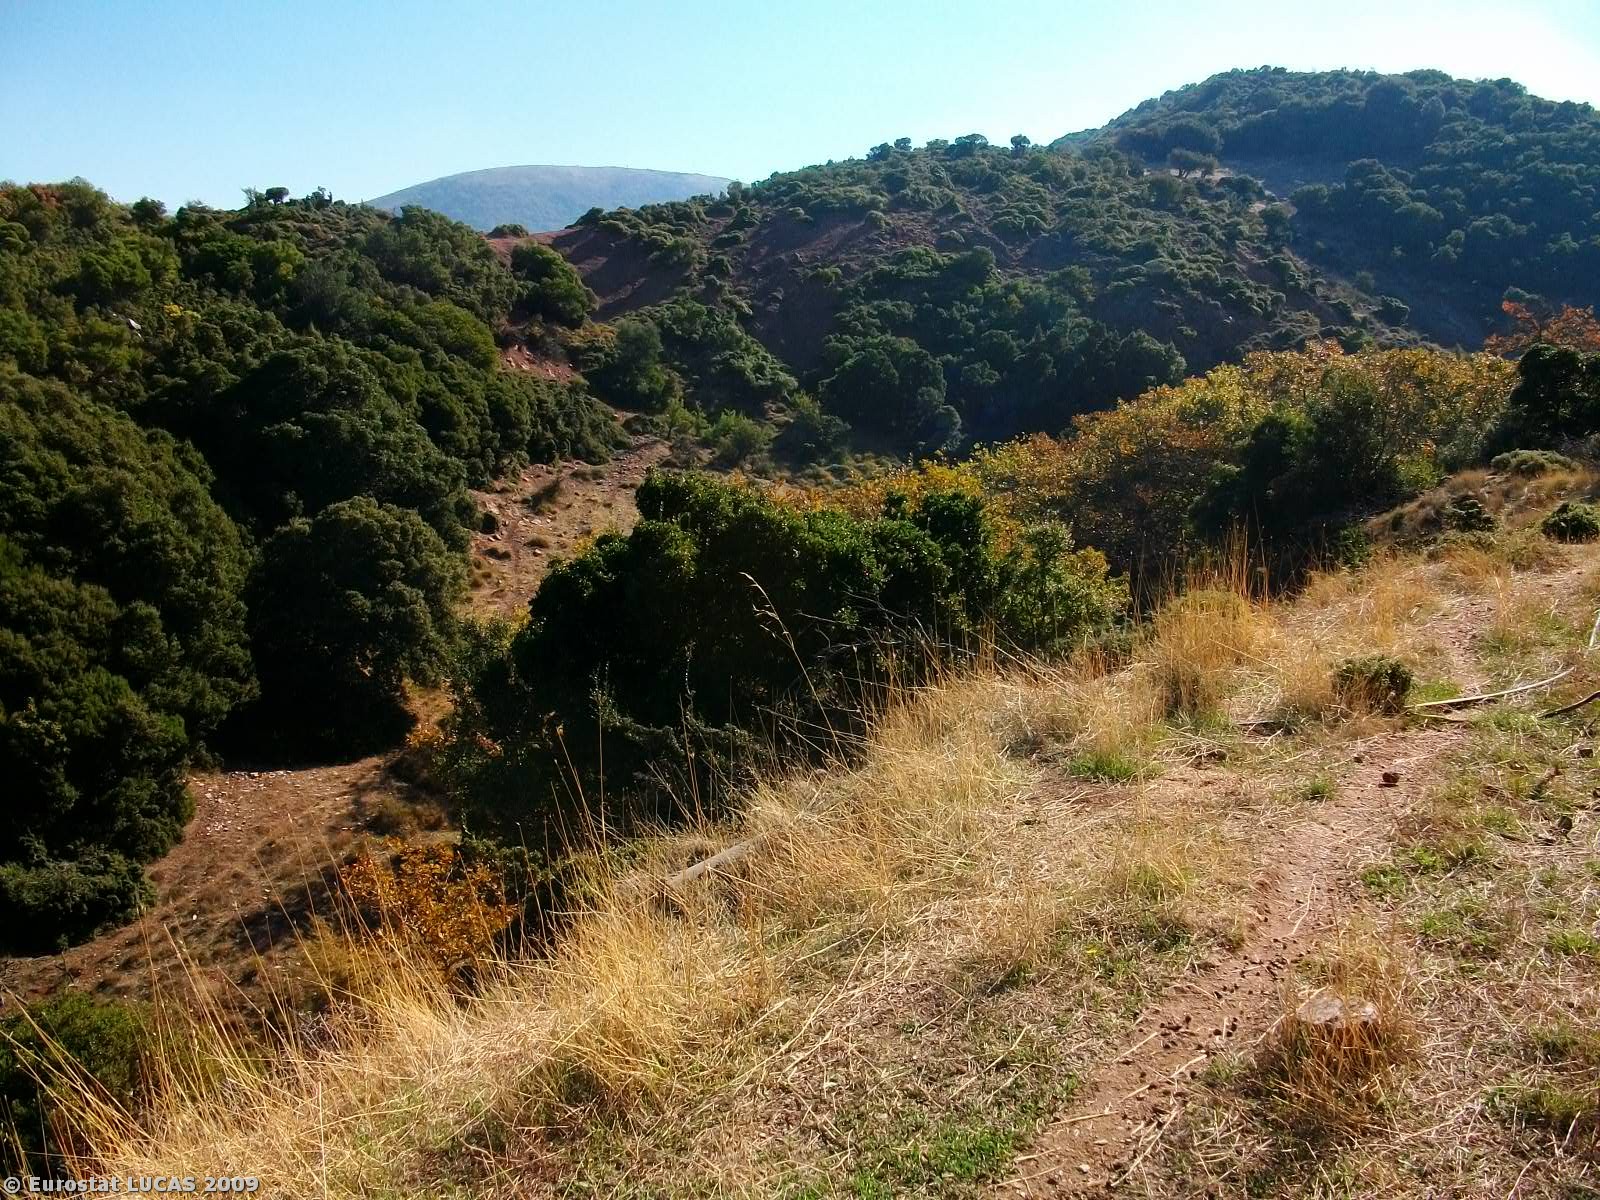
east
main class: Shrubland
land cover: Shrubland with sparse tree cover
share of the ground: > 75 %
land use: Unused
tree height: < 5 m
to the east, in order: Shrubland with sparse tree cover
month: October
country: GR
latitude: 38.1685
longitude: 21.7574
